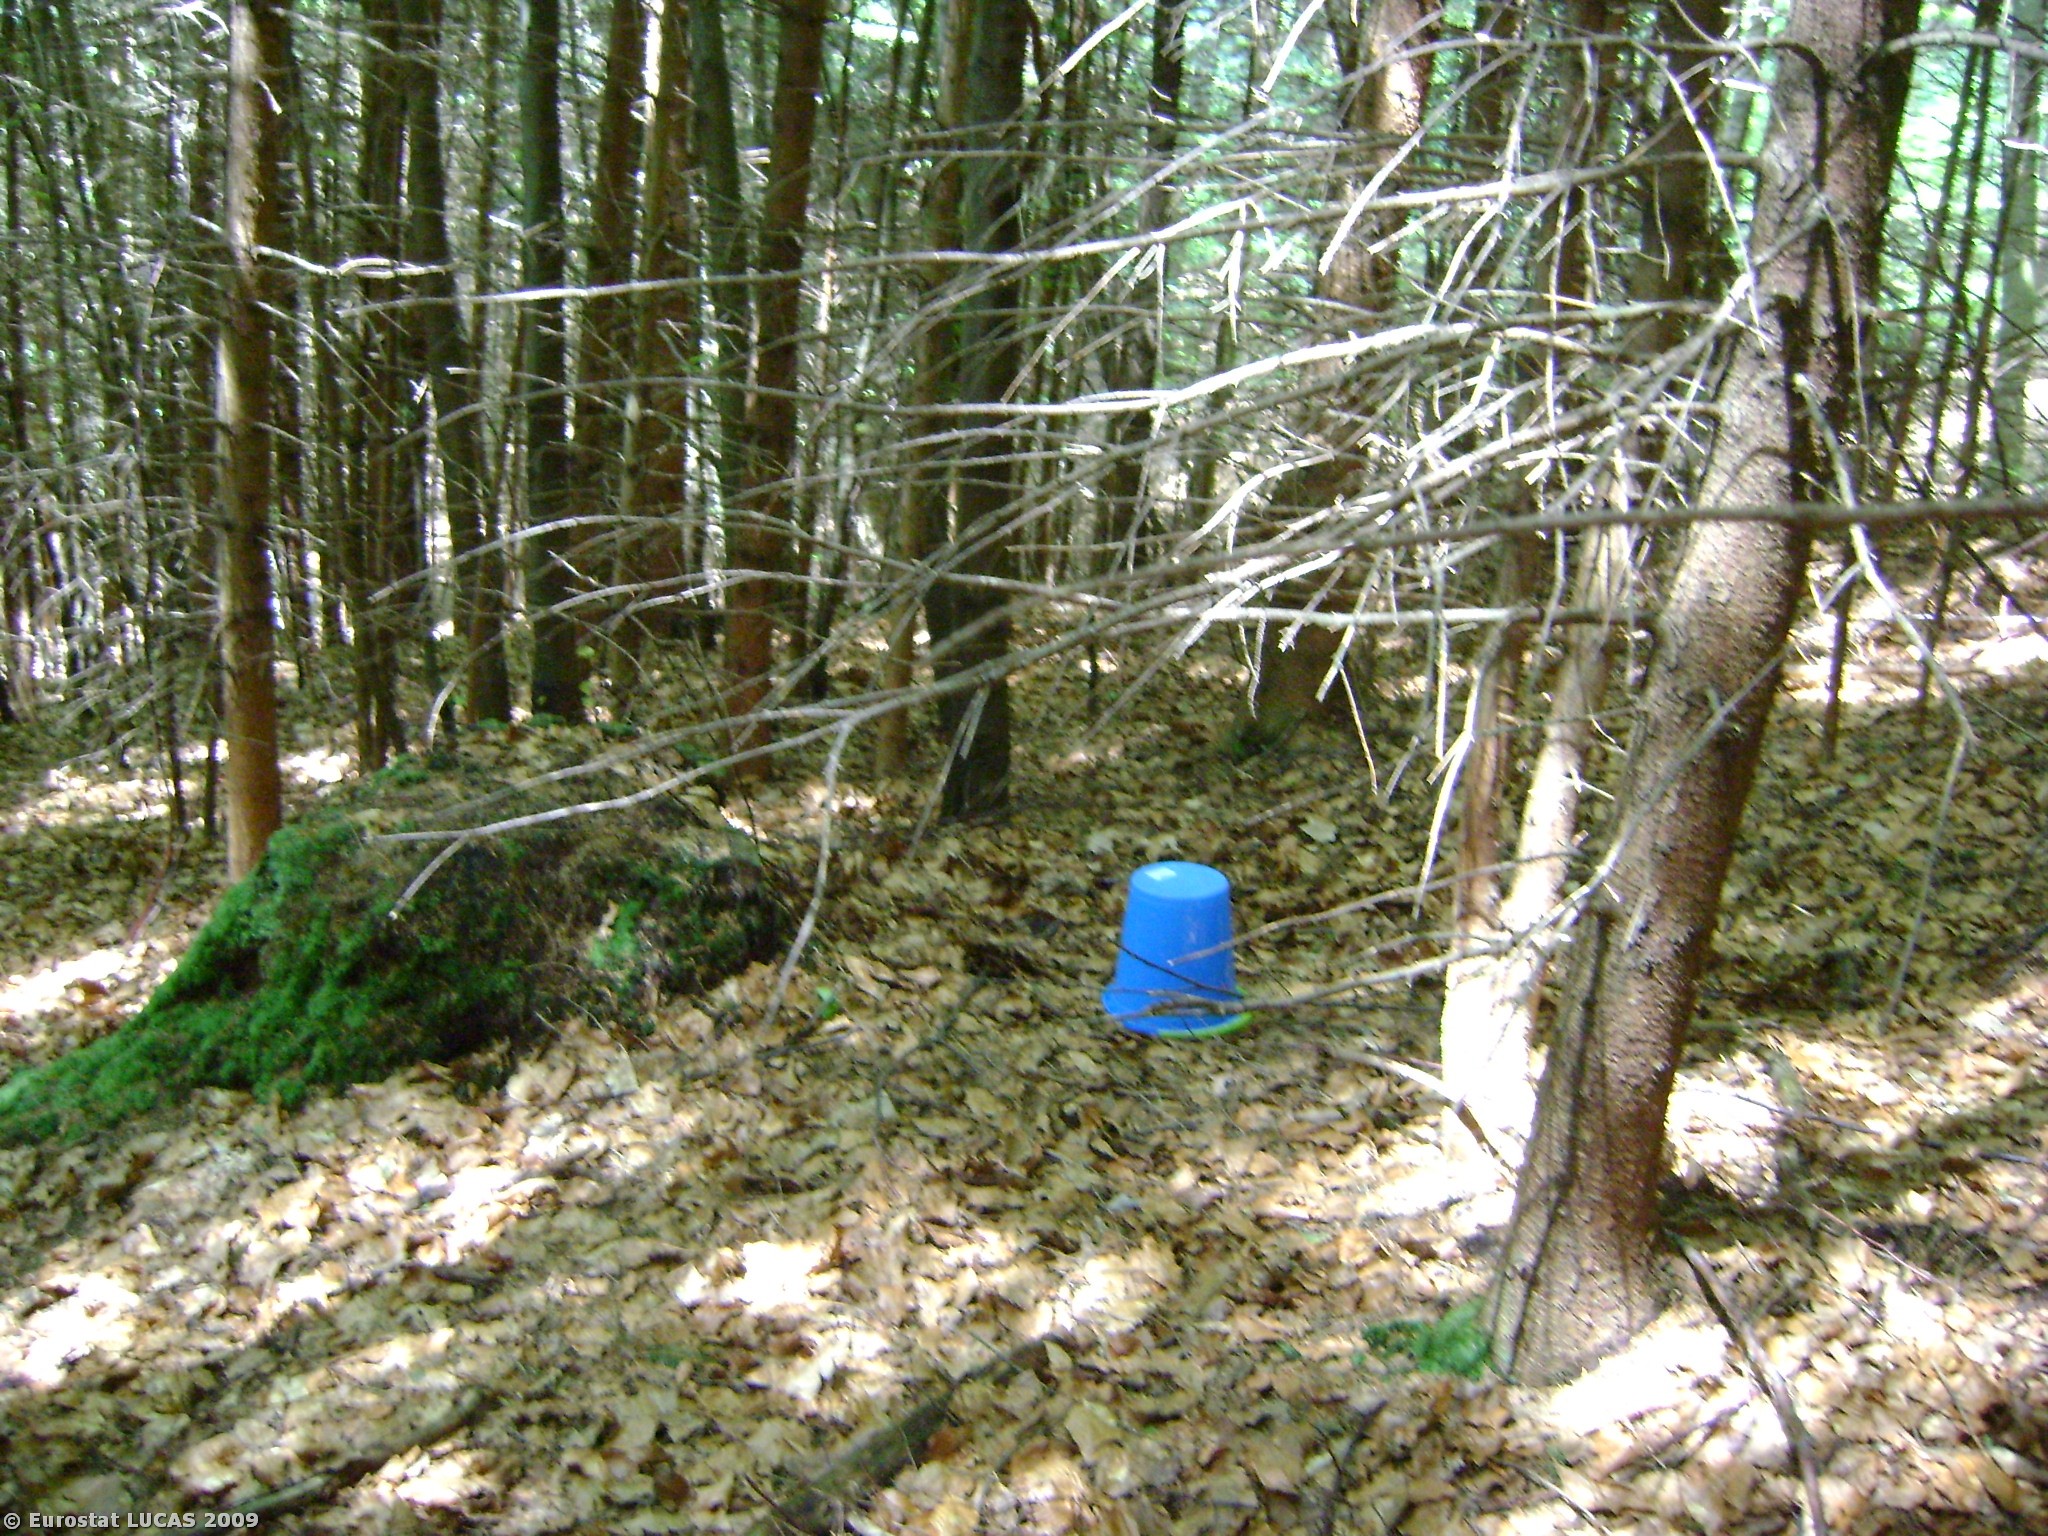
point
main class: Woodland
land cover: Coniferous woodland
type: boreal forest
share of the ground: > 75 %
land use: Forestry
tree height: > 5 m
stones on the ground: < 10 %
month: May
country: AT
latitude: 47.9235
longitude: 13.2509
